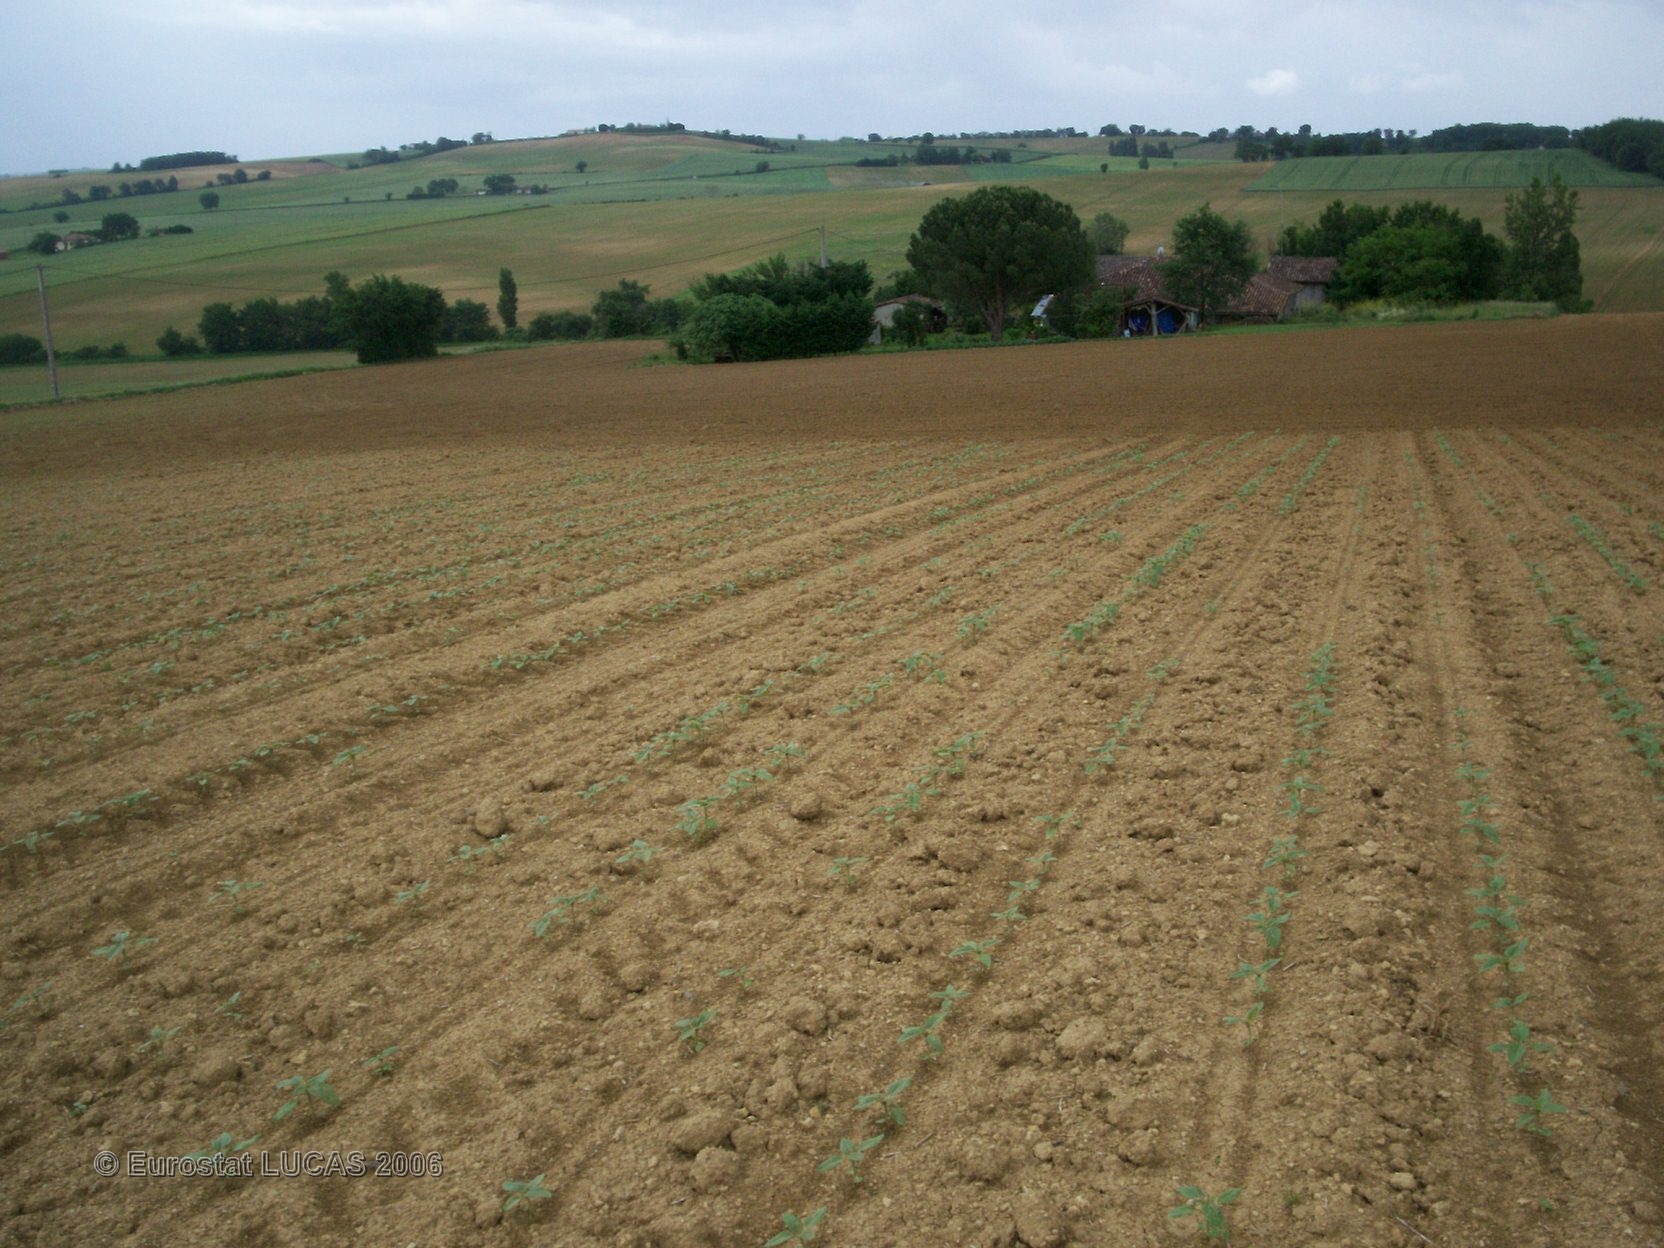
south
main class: Cropland
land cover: Soya
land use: Agriculture (excluding fallow land and kitchen gardens)
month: May
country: FR
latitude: 43.5755
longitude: 0.9732
